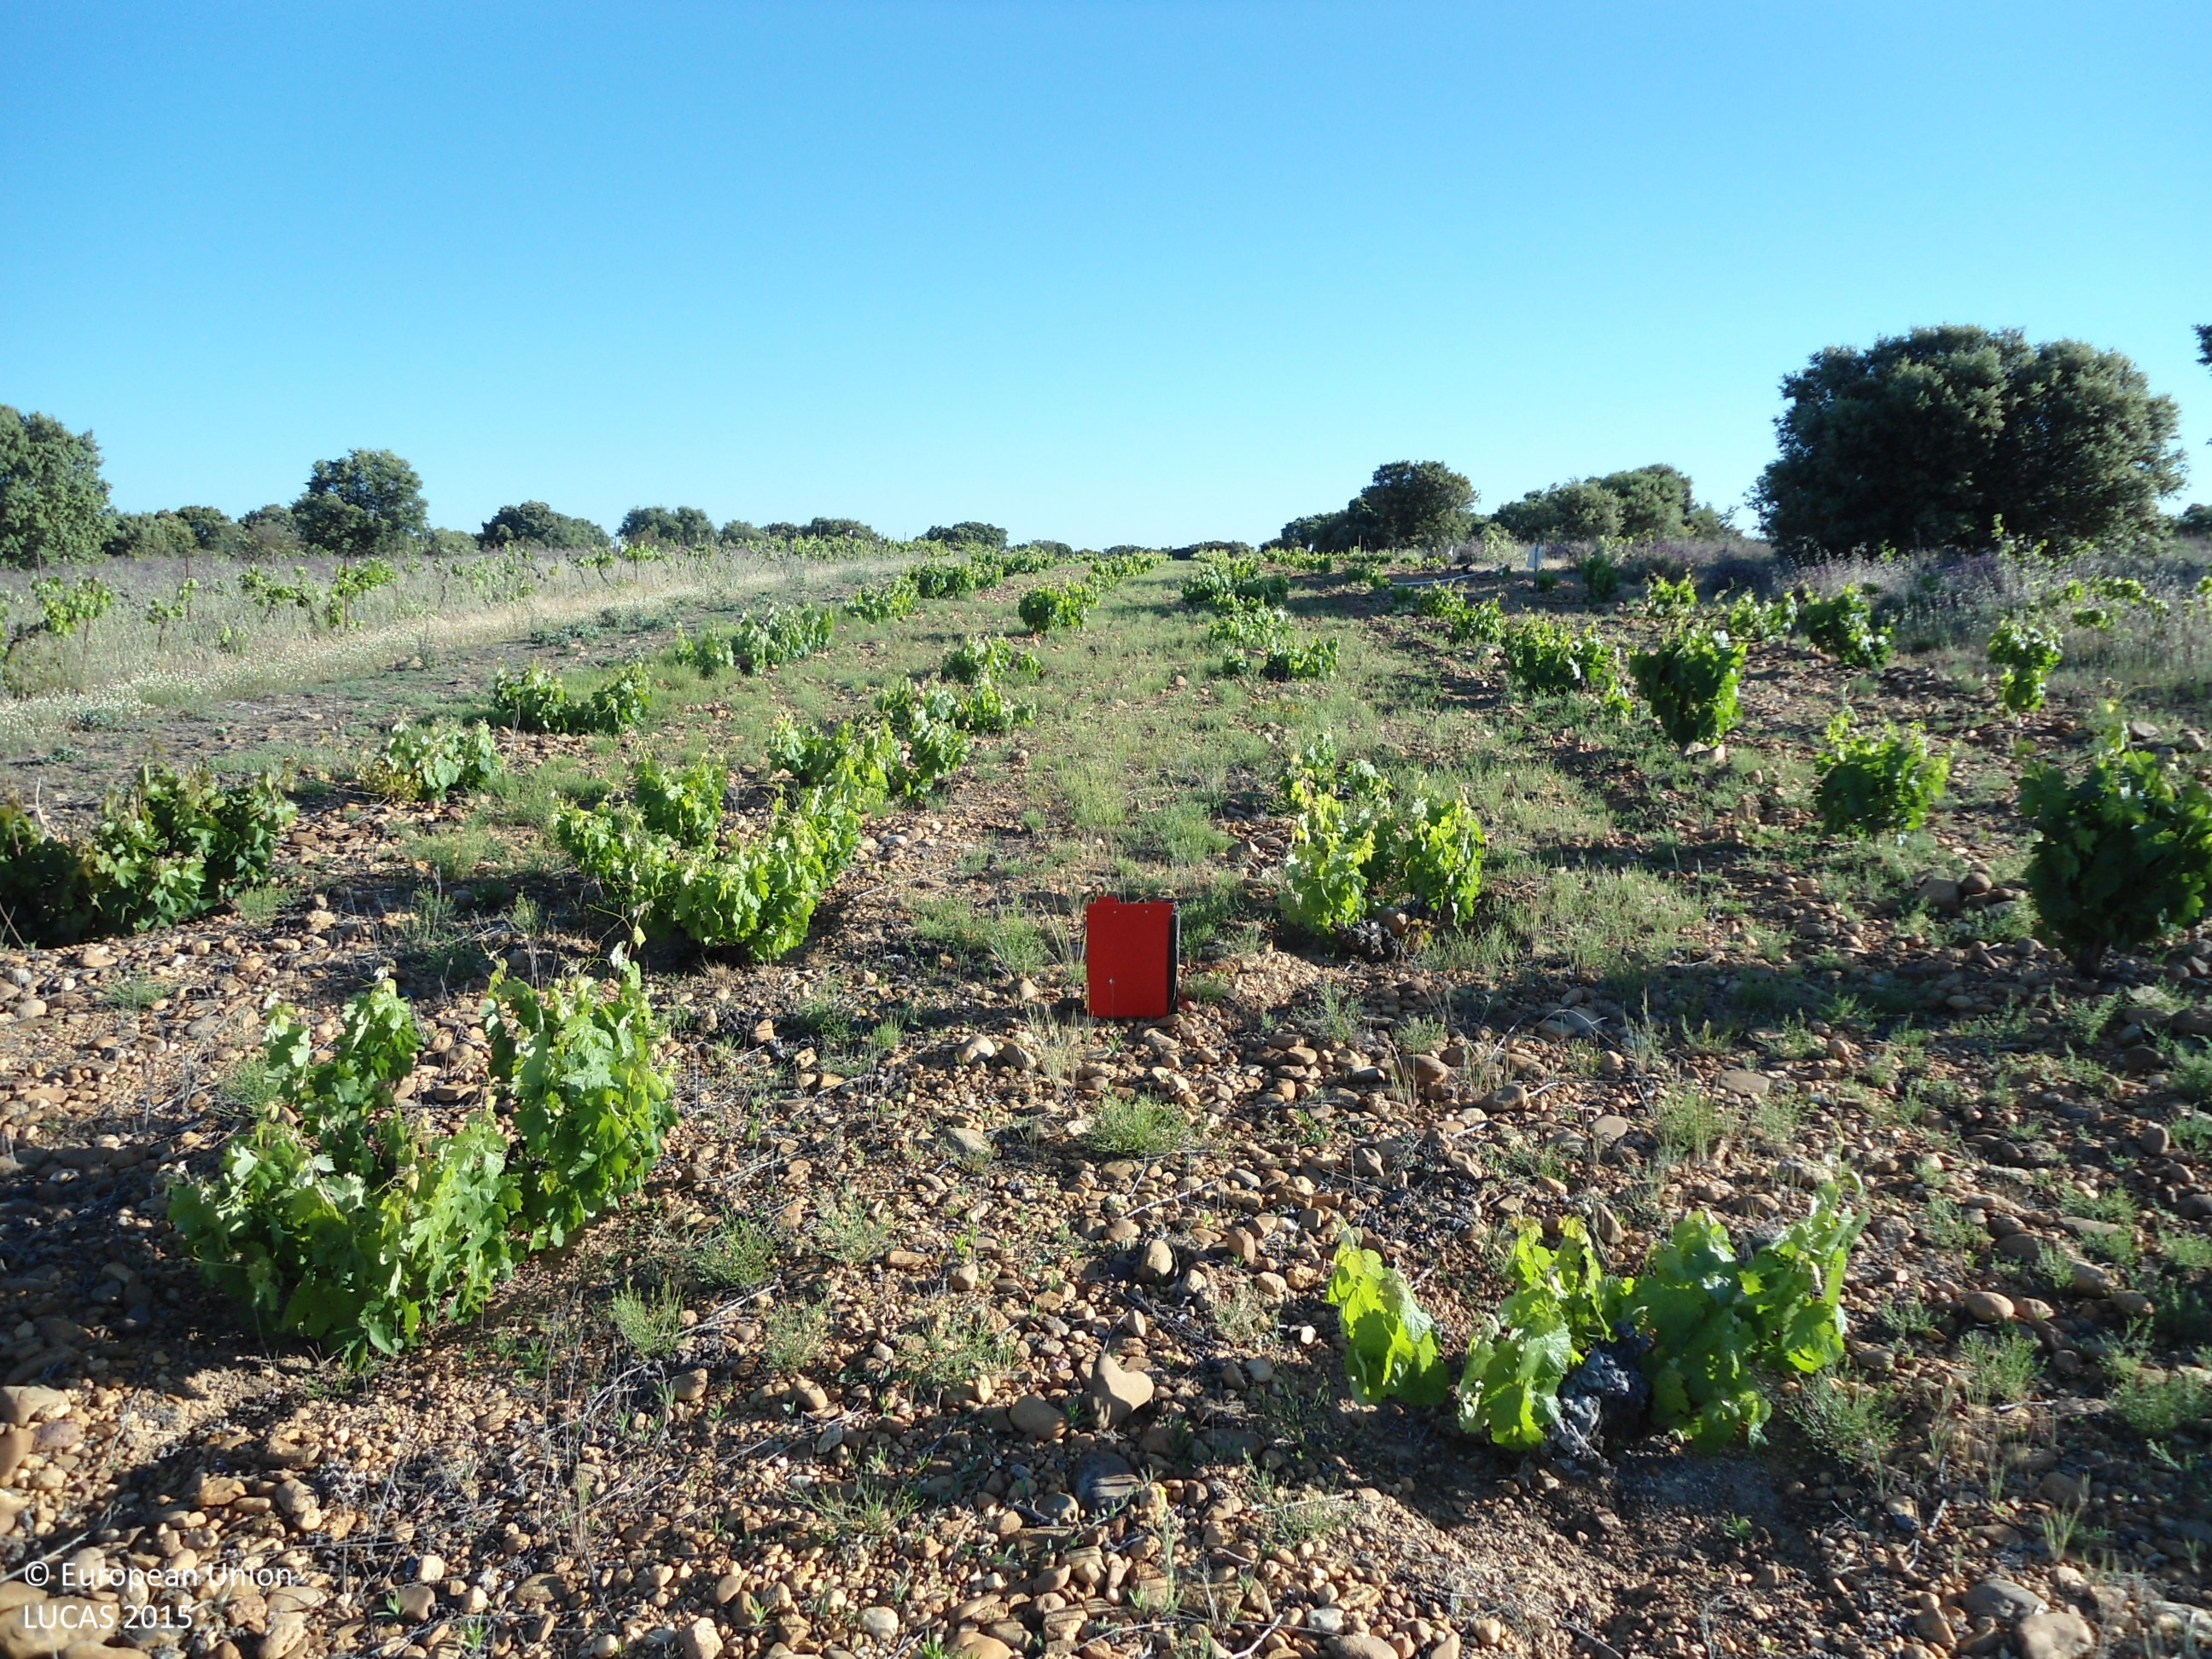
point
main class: Cropland
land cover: Vineyards
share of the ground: 25 - 50 %
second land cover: Other bare soil
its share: > 75 %
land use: Agriculture (excluding fallow land and kitchen gardens)
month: May
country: ES
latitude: 42.0090
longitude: -5.9268
